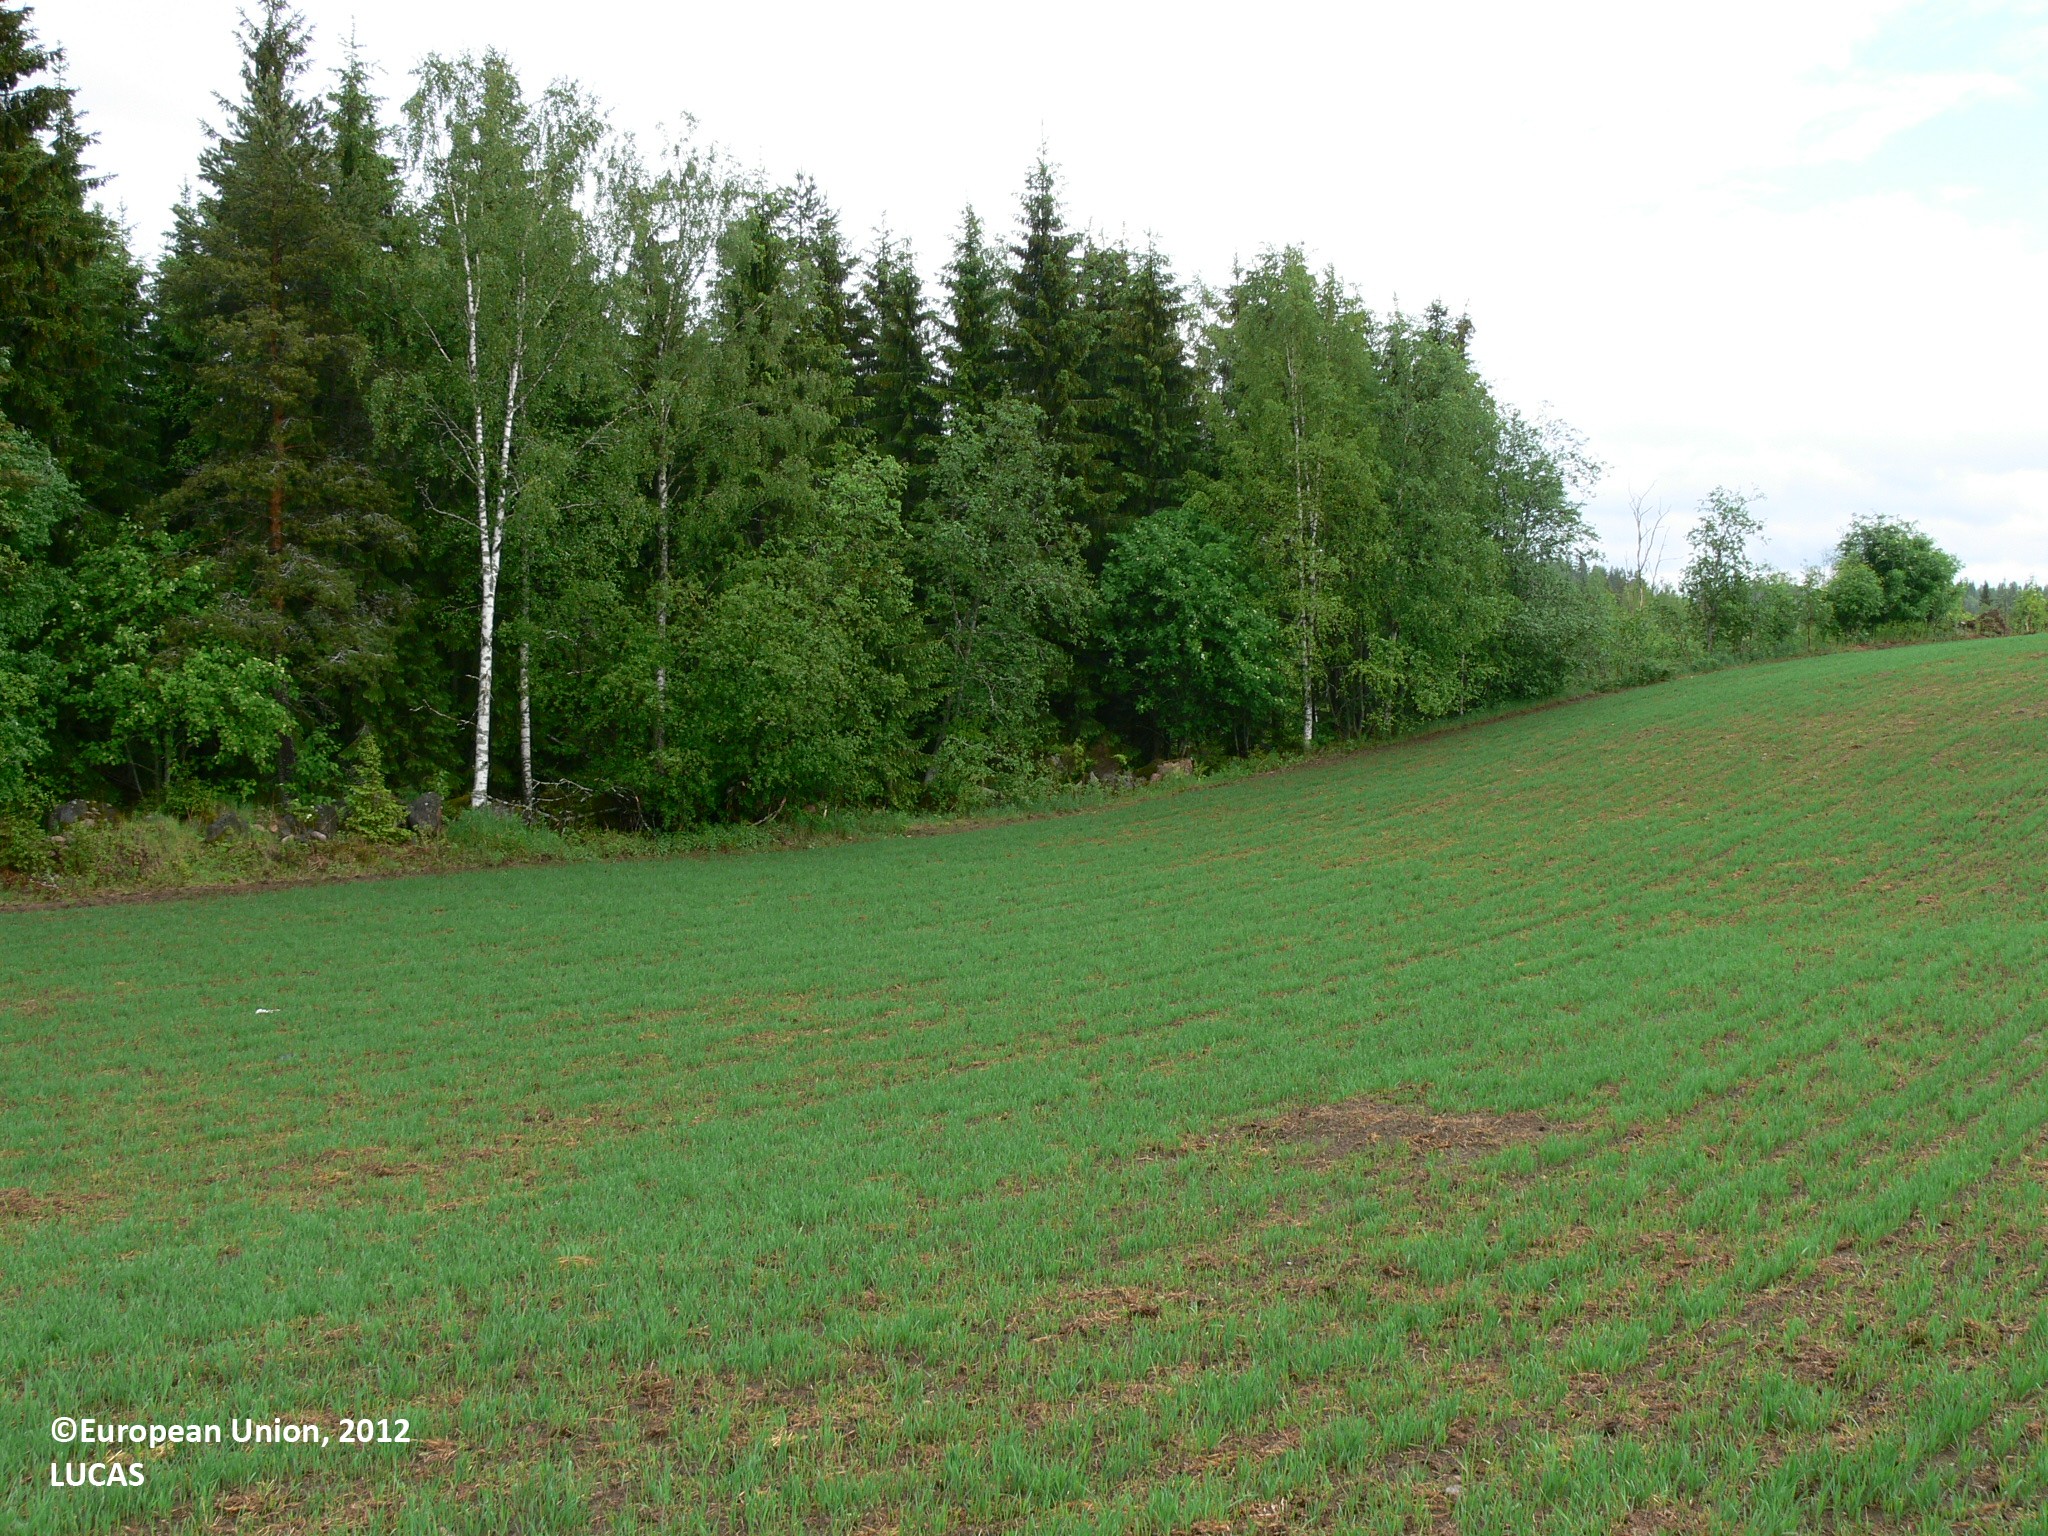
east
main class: Cropland
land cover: Oats
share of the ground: 25 - 50 %
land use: Agriculture (excluding fallow land and kitchen gardens)
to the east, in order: Oats; Electric lines; Other mixed woodland; Shruby margins; Paved roads, cycling and walking lanes; Grass margins; Other mixed woodland; Inland running water; Other mixed woodland
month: June
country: FI
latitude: 62.4221
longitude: 30.4365
